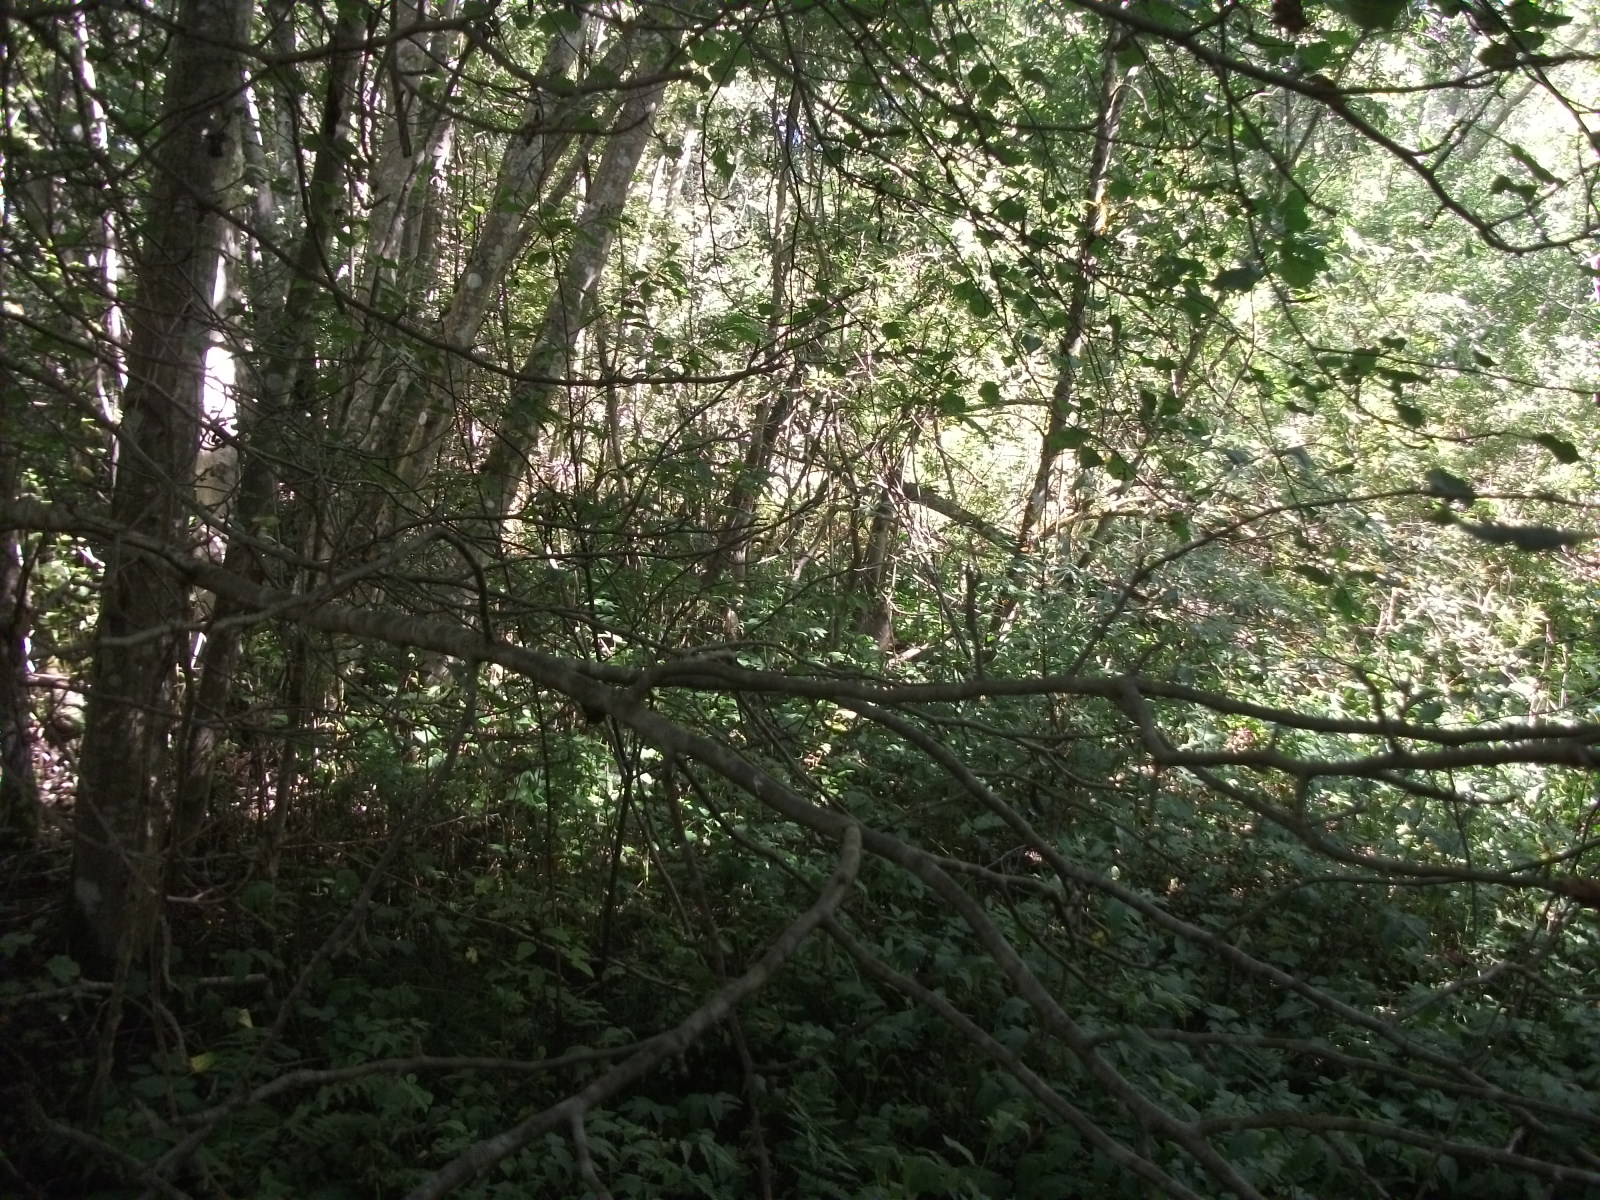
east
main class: Woodland
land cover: Broadleaved woodland
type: non-riverine alder, birch or aspen forest
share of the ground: > 75 %
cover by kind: broadleaved forest trees 85 %, herbaceous plants 10 %, shrubs 5 %
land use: Forestry
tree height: > 5 m
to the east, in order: Broadleaved woodland; Pine dominated mixed woodland; Broadleaved woodland; Ponds and wetlands; Broadleaved woodland; Other mixed woodland; Broadleaved woodland
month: August
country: LV
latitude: 56.6324
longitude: 26.0954
